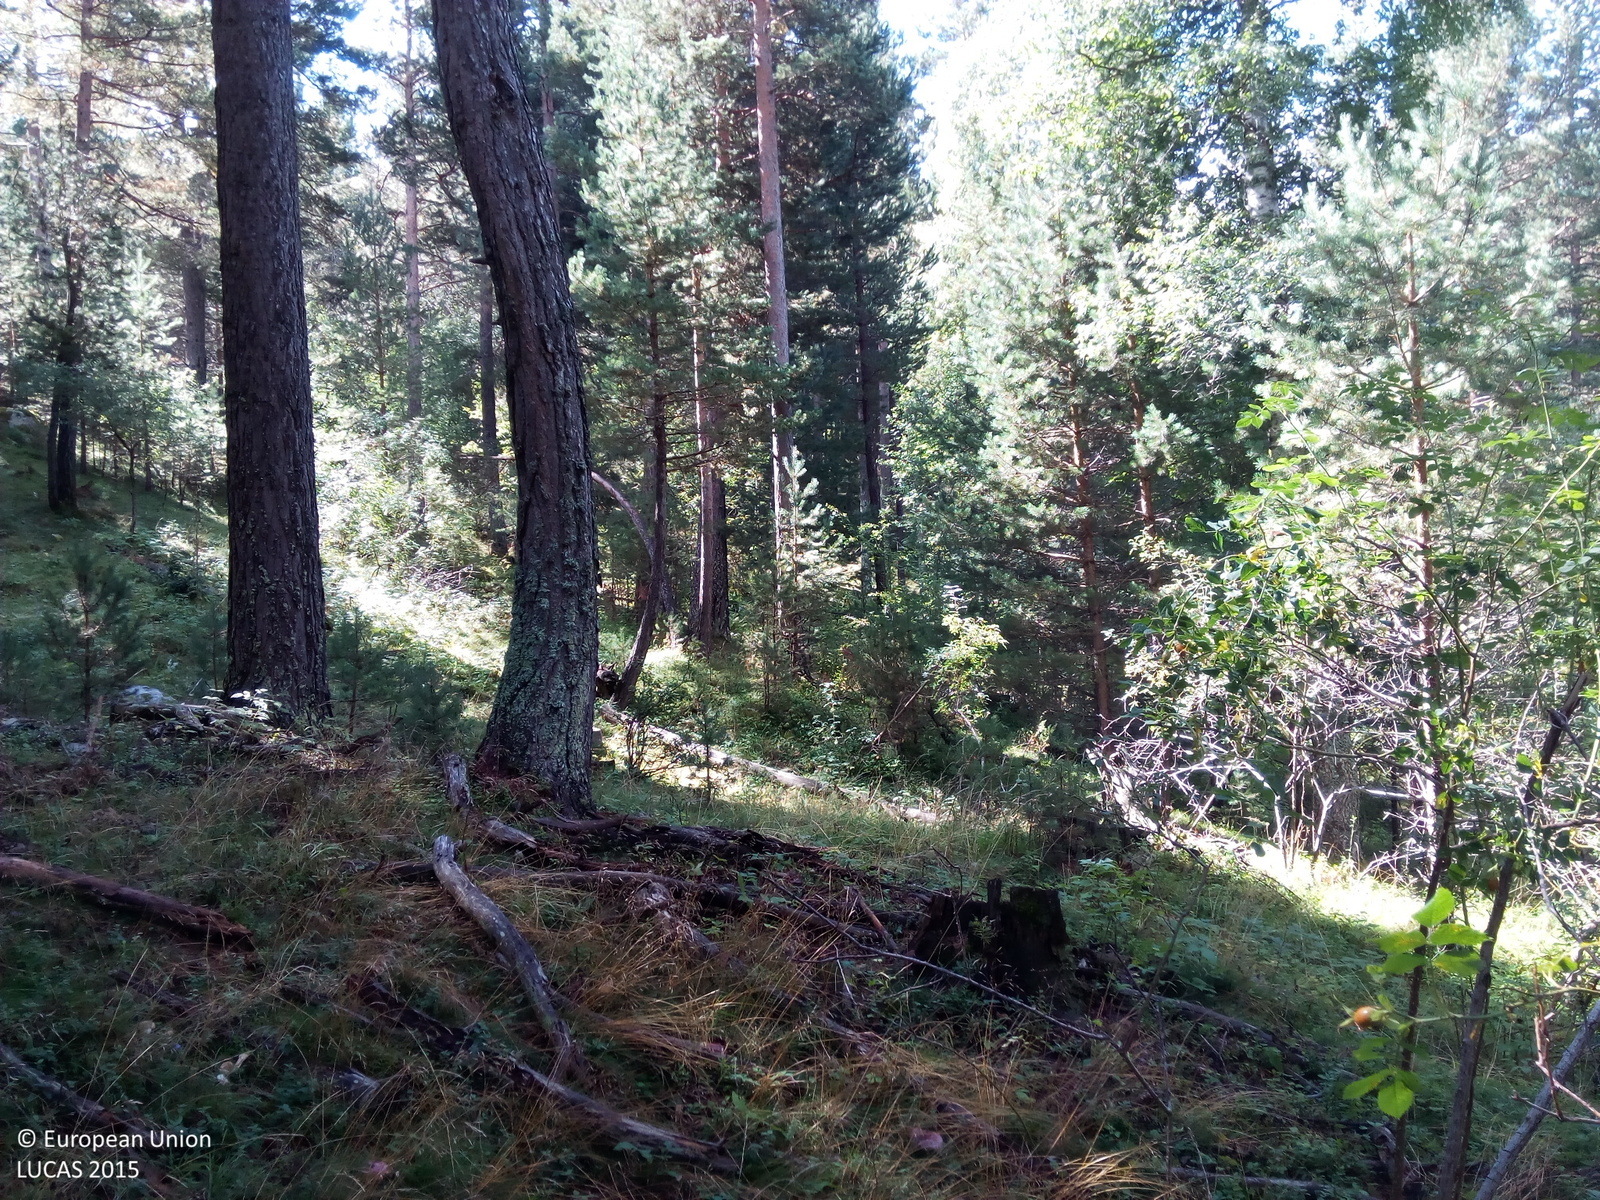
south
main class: Woodland
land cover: Pine dominated coniferous woodland
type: alpine coniferous forest
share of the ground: > 75 %
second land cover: Grassland without tree/shrub cover
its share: 10 - 25 %
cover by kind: coniferous forest trees 75 %, shrubs 15 %, herbaceous plants 10 %
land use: Forestry
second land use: Agriculture (excluding fallow land and kitchen gardens)
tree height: > 5 m
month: September
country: ES
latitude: 42.6471
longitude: 0.3549
